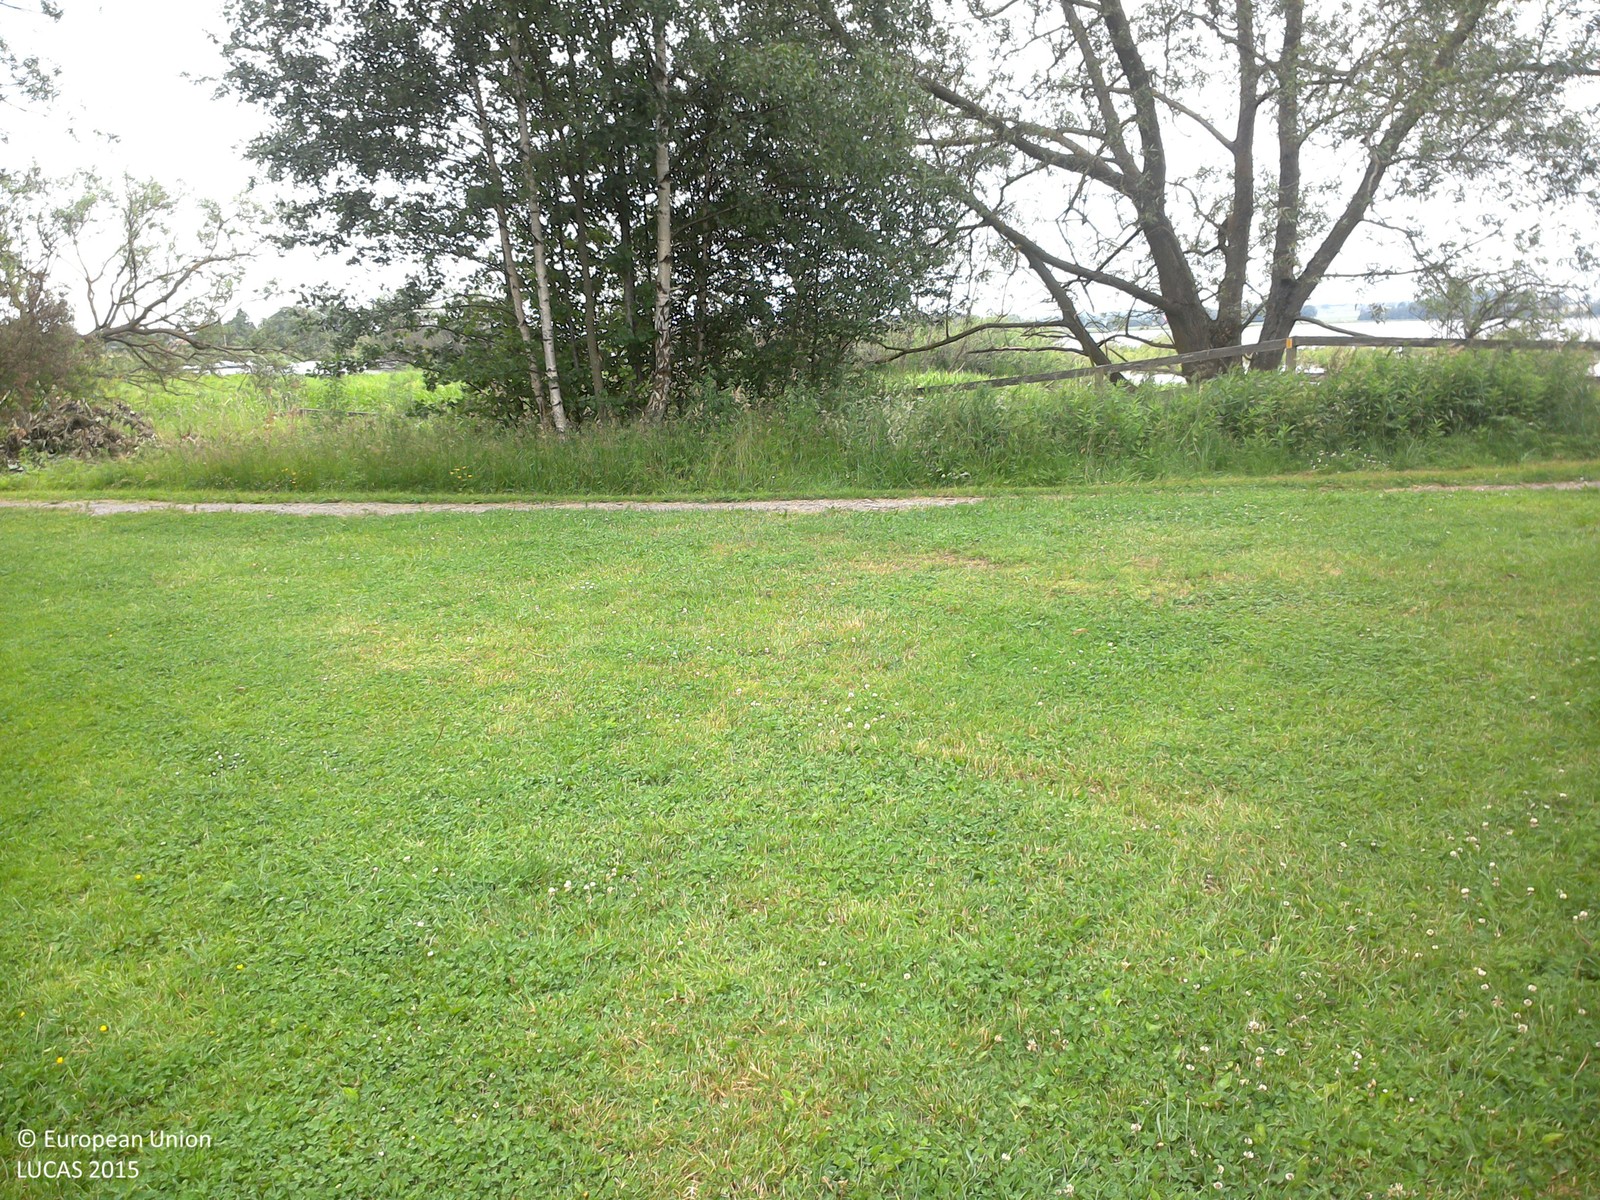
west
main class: Grassland
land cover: Grassland without tree/shrub cover
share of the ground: > 75 %
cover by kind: herbaceous plants 100 %
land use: Agriculture (excluding fallow land and kitchen gardens)
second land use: Amenities, museums, leisure
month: June
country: SE
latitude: 58.4650
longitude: 15.5655
